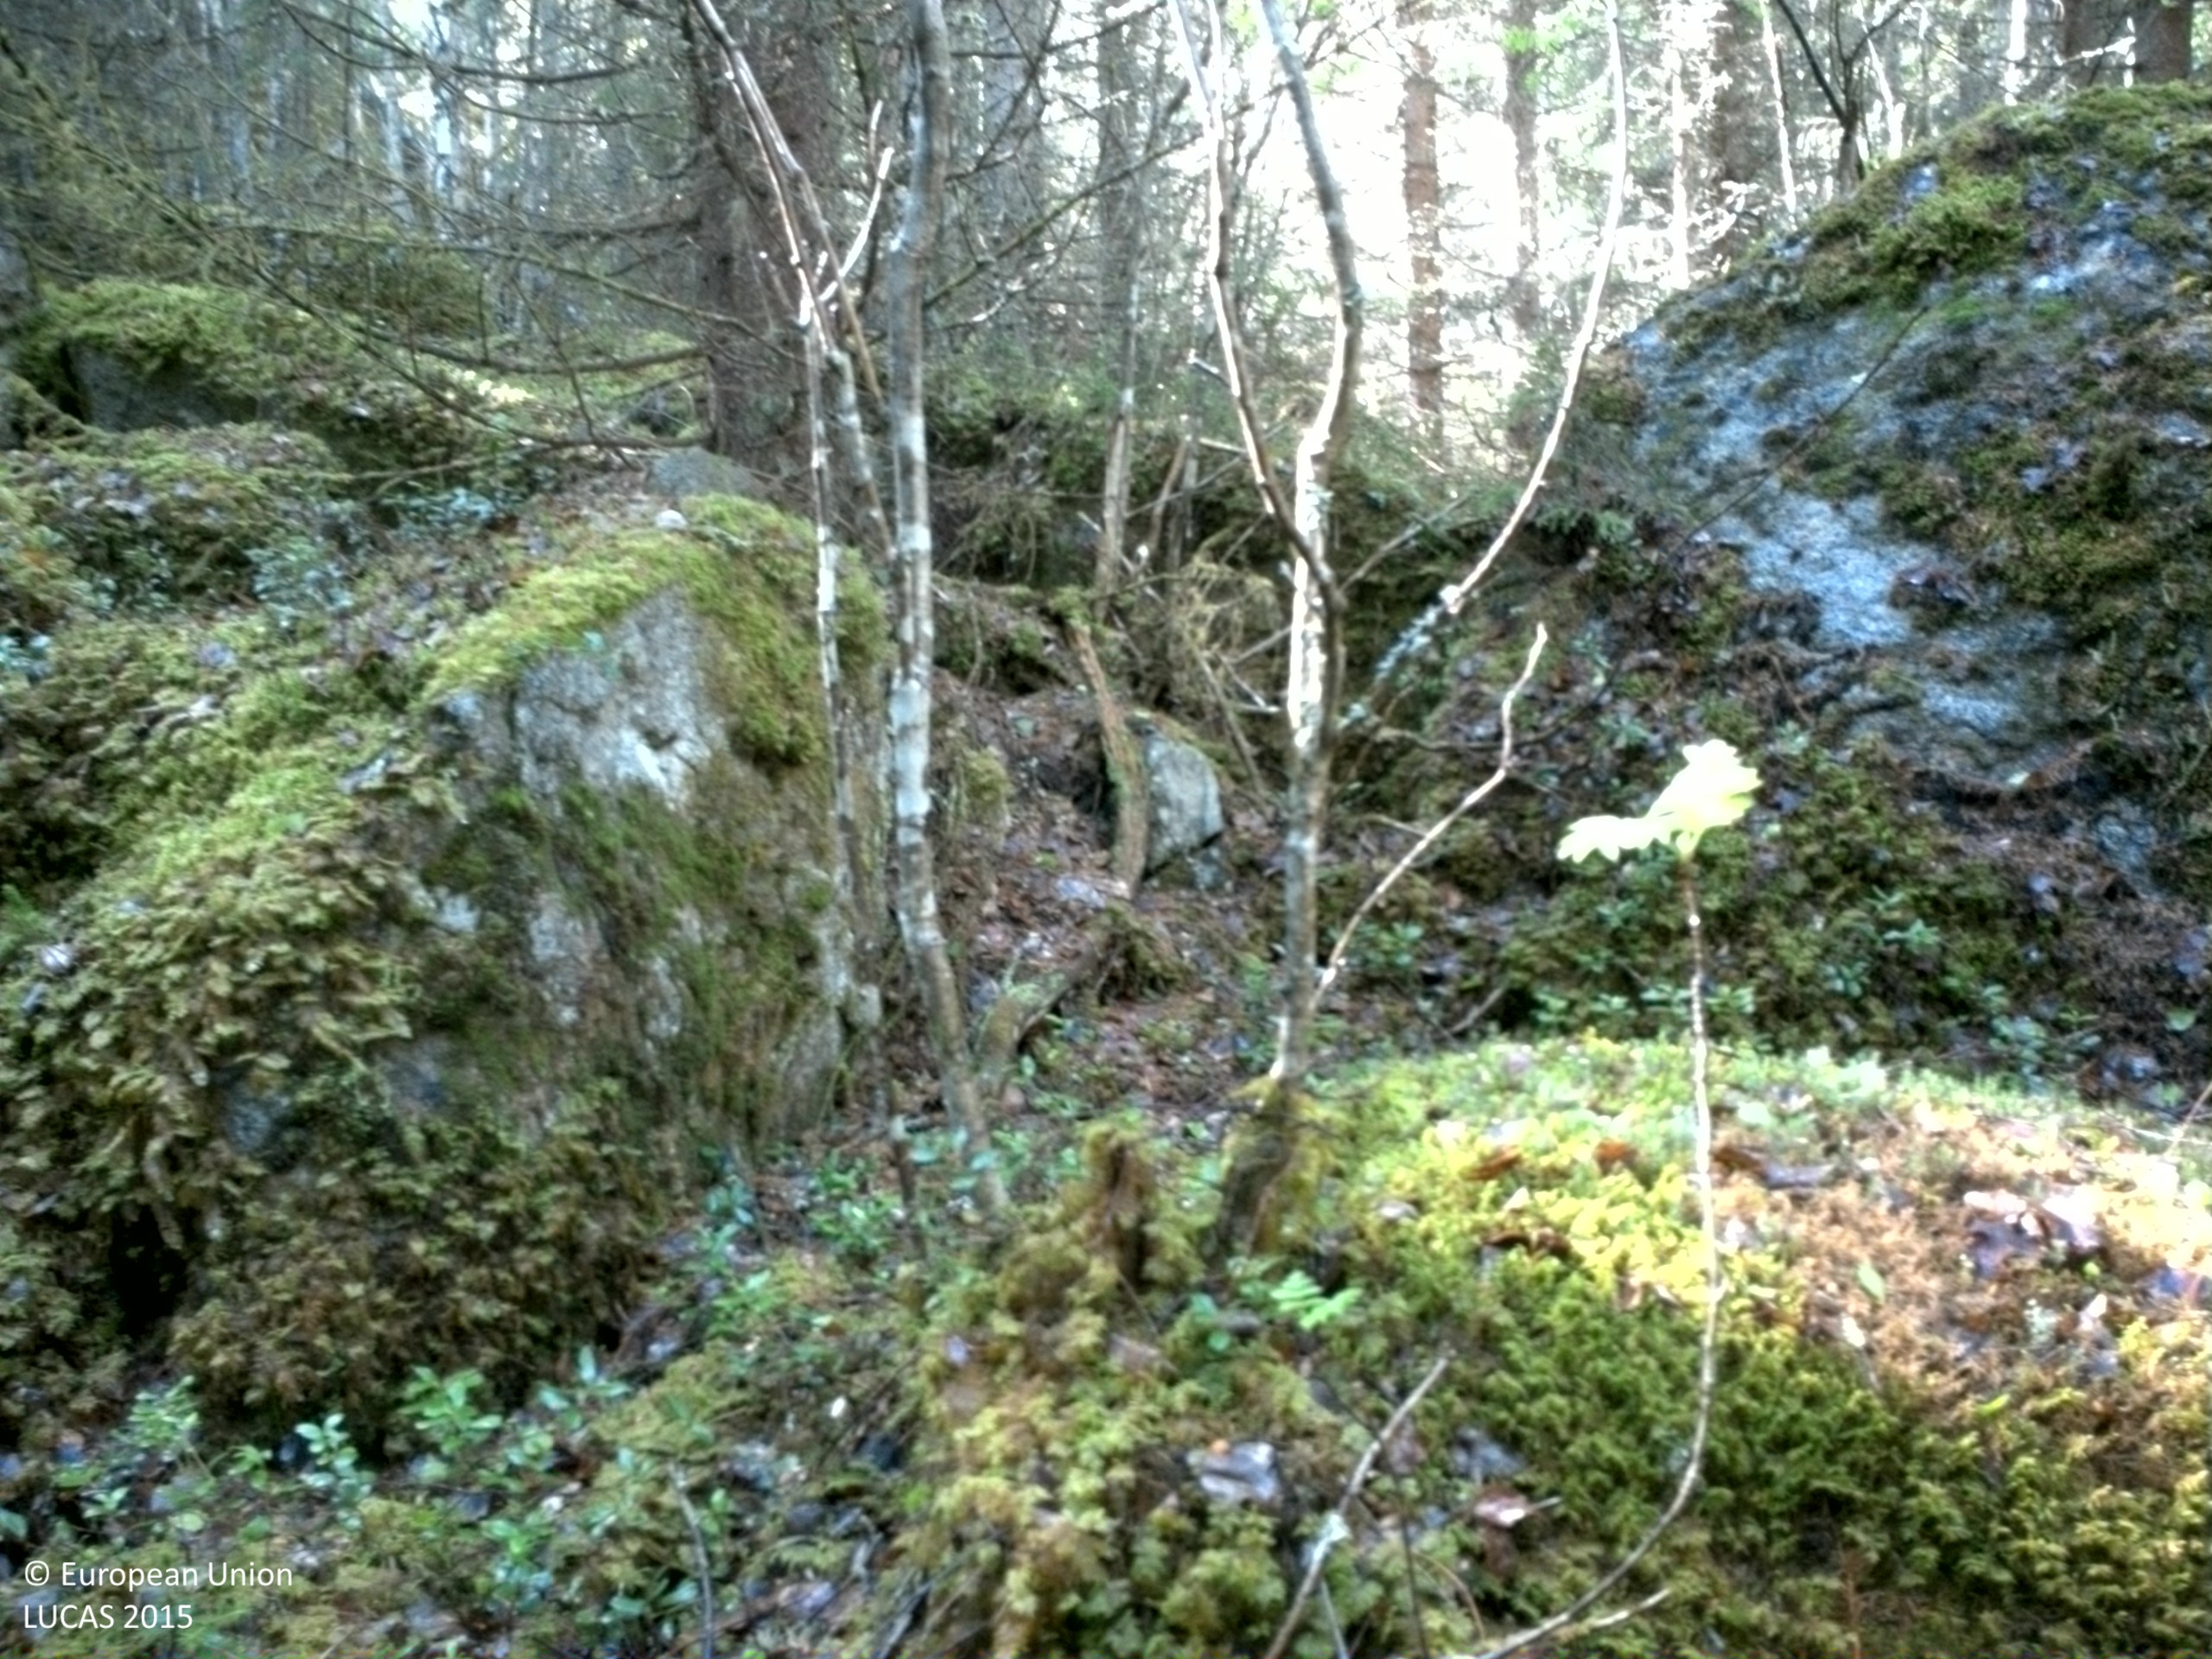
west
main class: Woodland
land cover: Spruce dominated coniferous woodland
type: boreal forest
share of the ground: > 75 %
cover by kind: coniferous forest trees 90 %, lichens and mosses 10 %
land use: Forestry
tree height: > 5 m
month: June
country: SE
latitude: 63.1229
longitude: 17.6894
